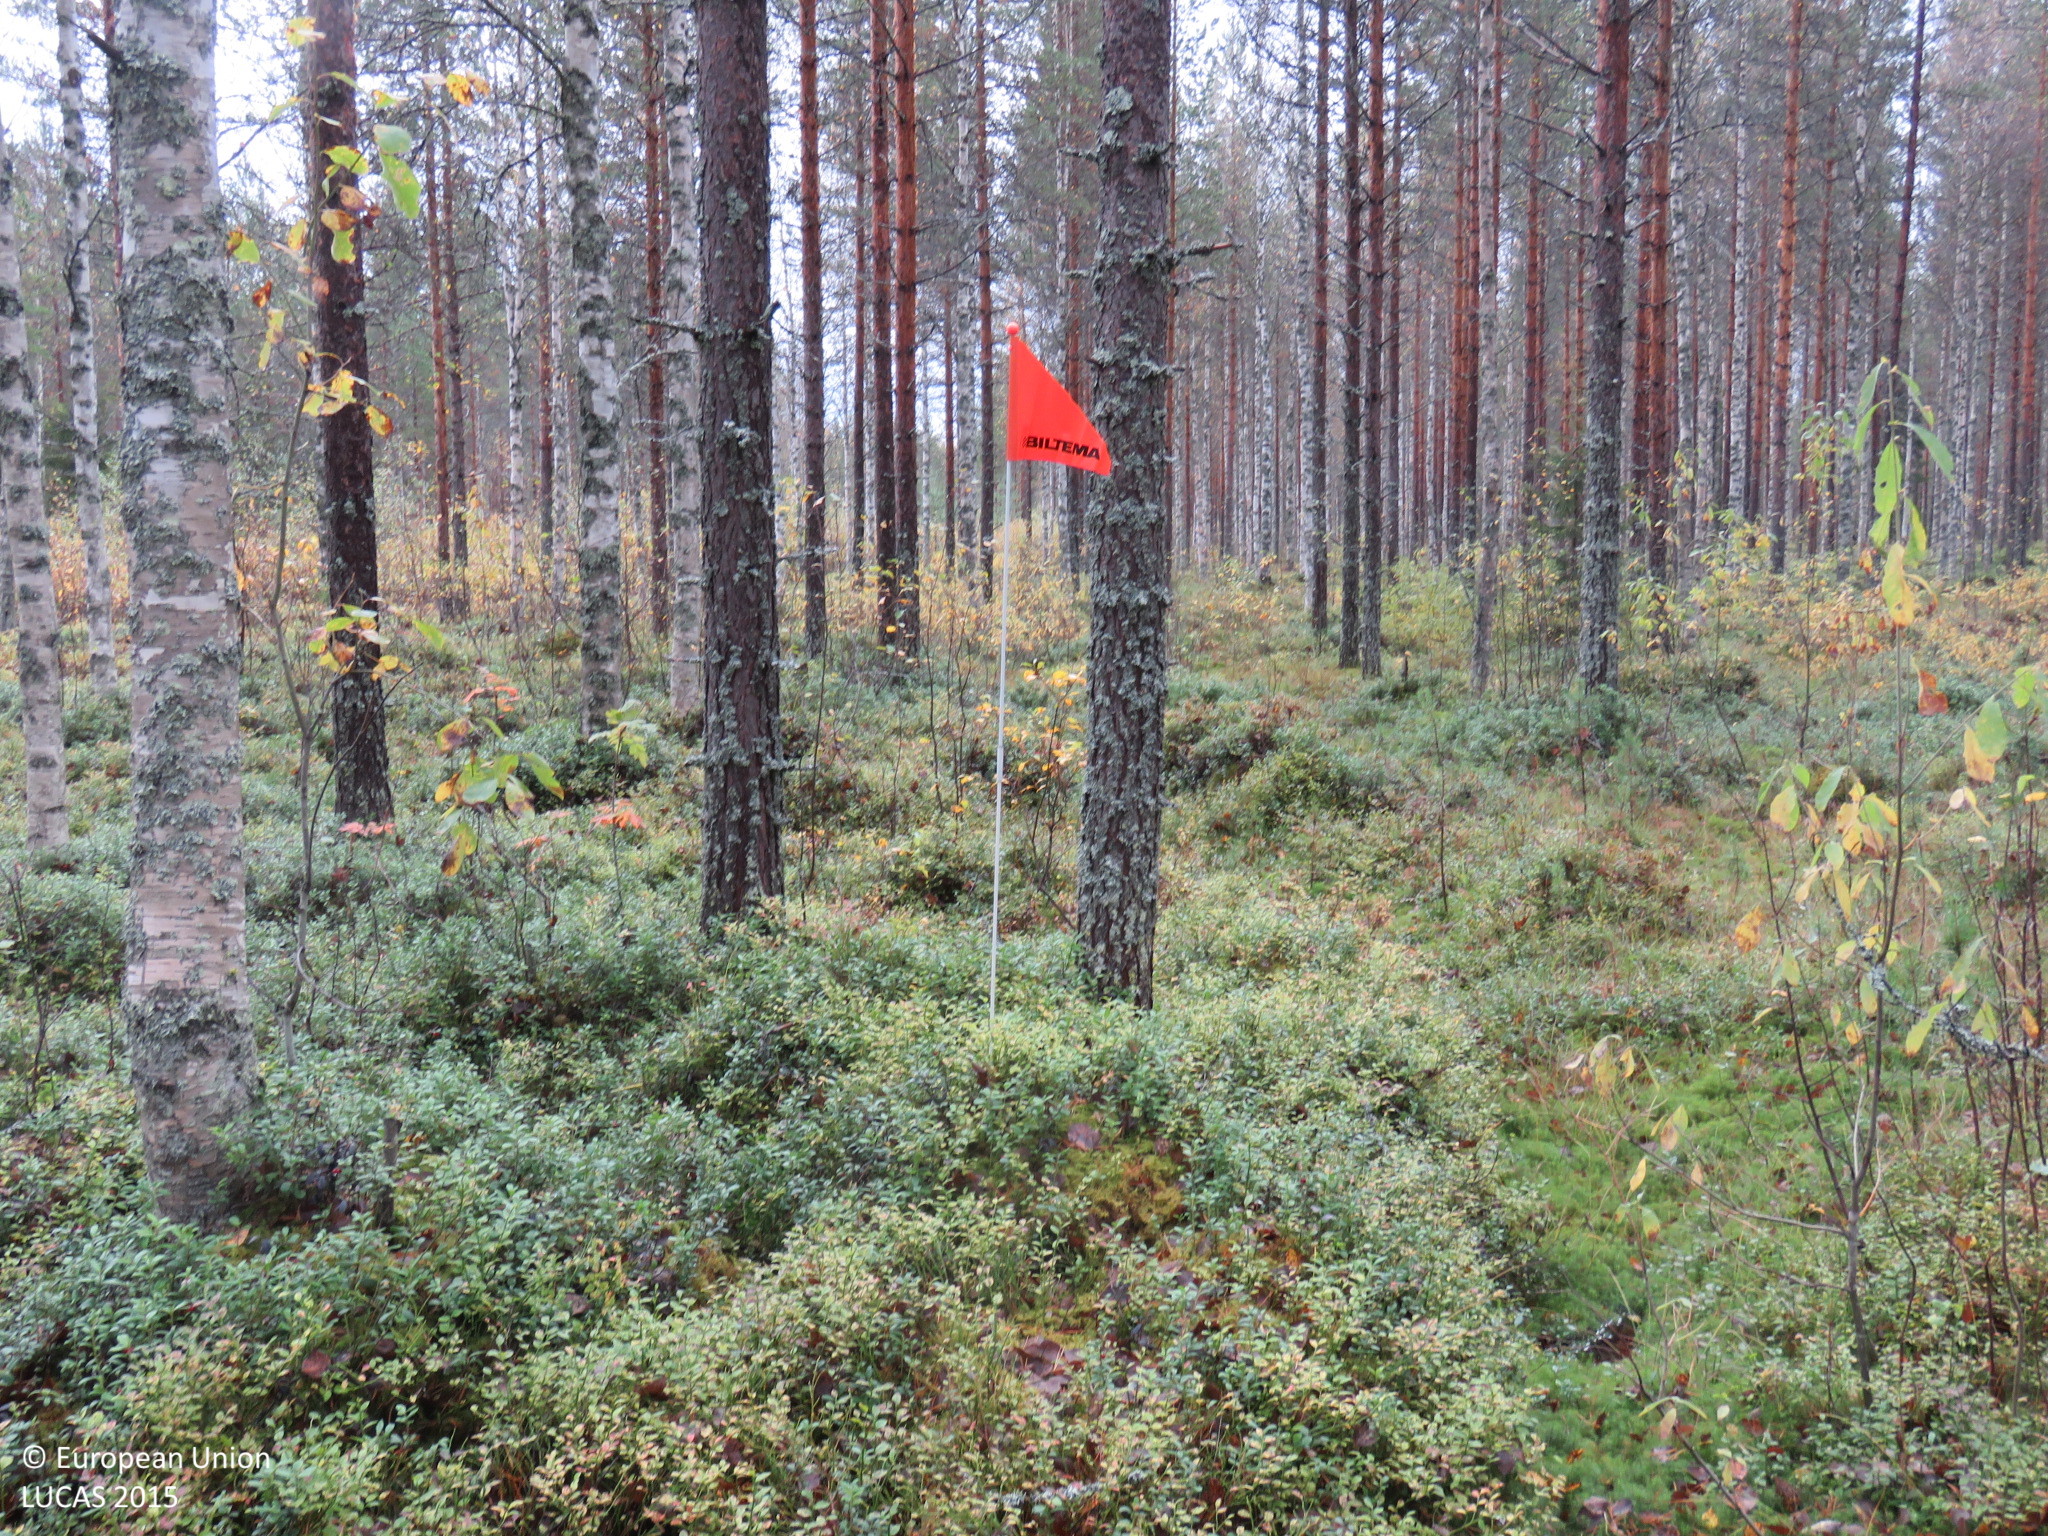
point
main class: Woodland
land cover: Pine dominated mixed woodland
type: boreal forest
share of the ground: 50 - 75 %
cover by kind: broadleaved forest trees 40 %, coniferous forest trees 30 %, shrubs 20 %, herbaceous plants 5 %, lichens and mosses 5 %
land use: Forestry
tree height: > 5 m
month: September
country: FI
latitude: 64.8787
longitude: 26.8604
